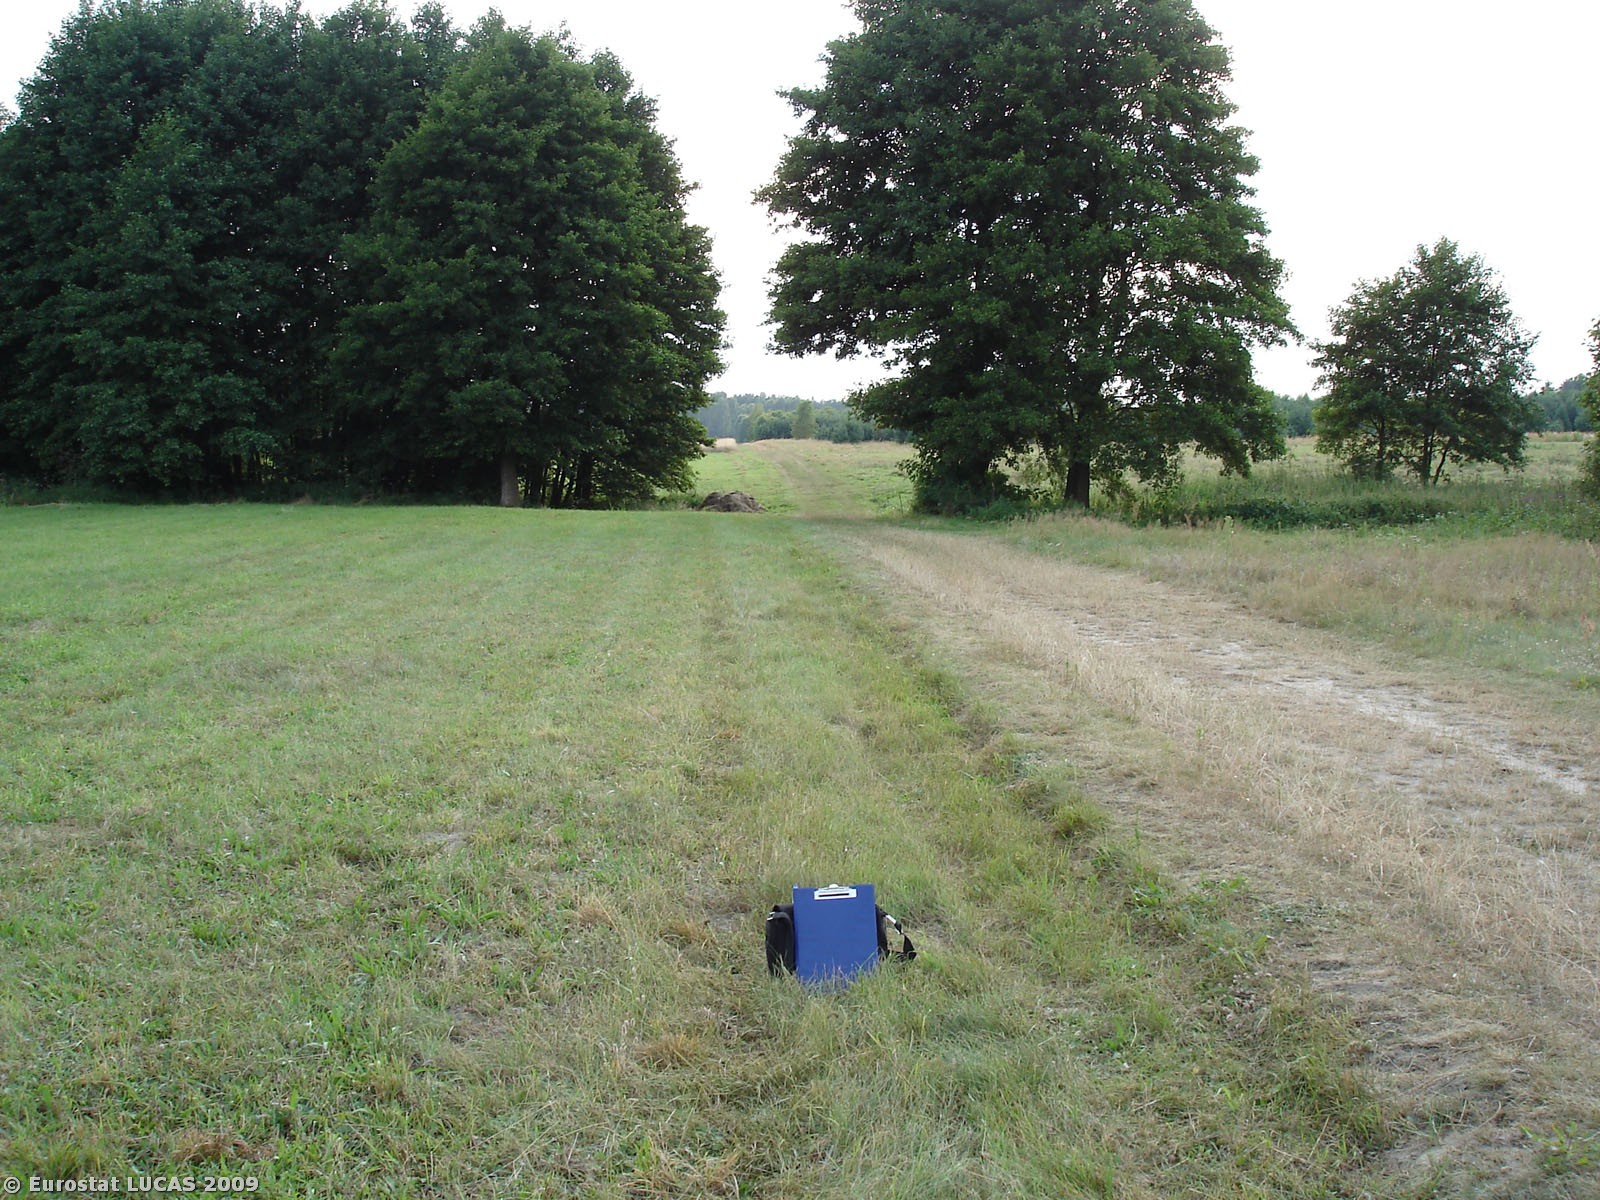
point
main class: Grassland
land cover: Grassland without tree/shrub cover
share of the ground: > 75 %
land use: Agriculture (excluding fallow land and kitchen gardens)
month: August
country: PL
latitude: 50.8531
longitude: 18.8432
